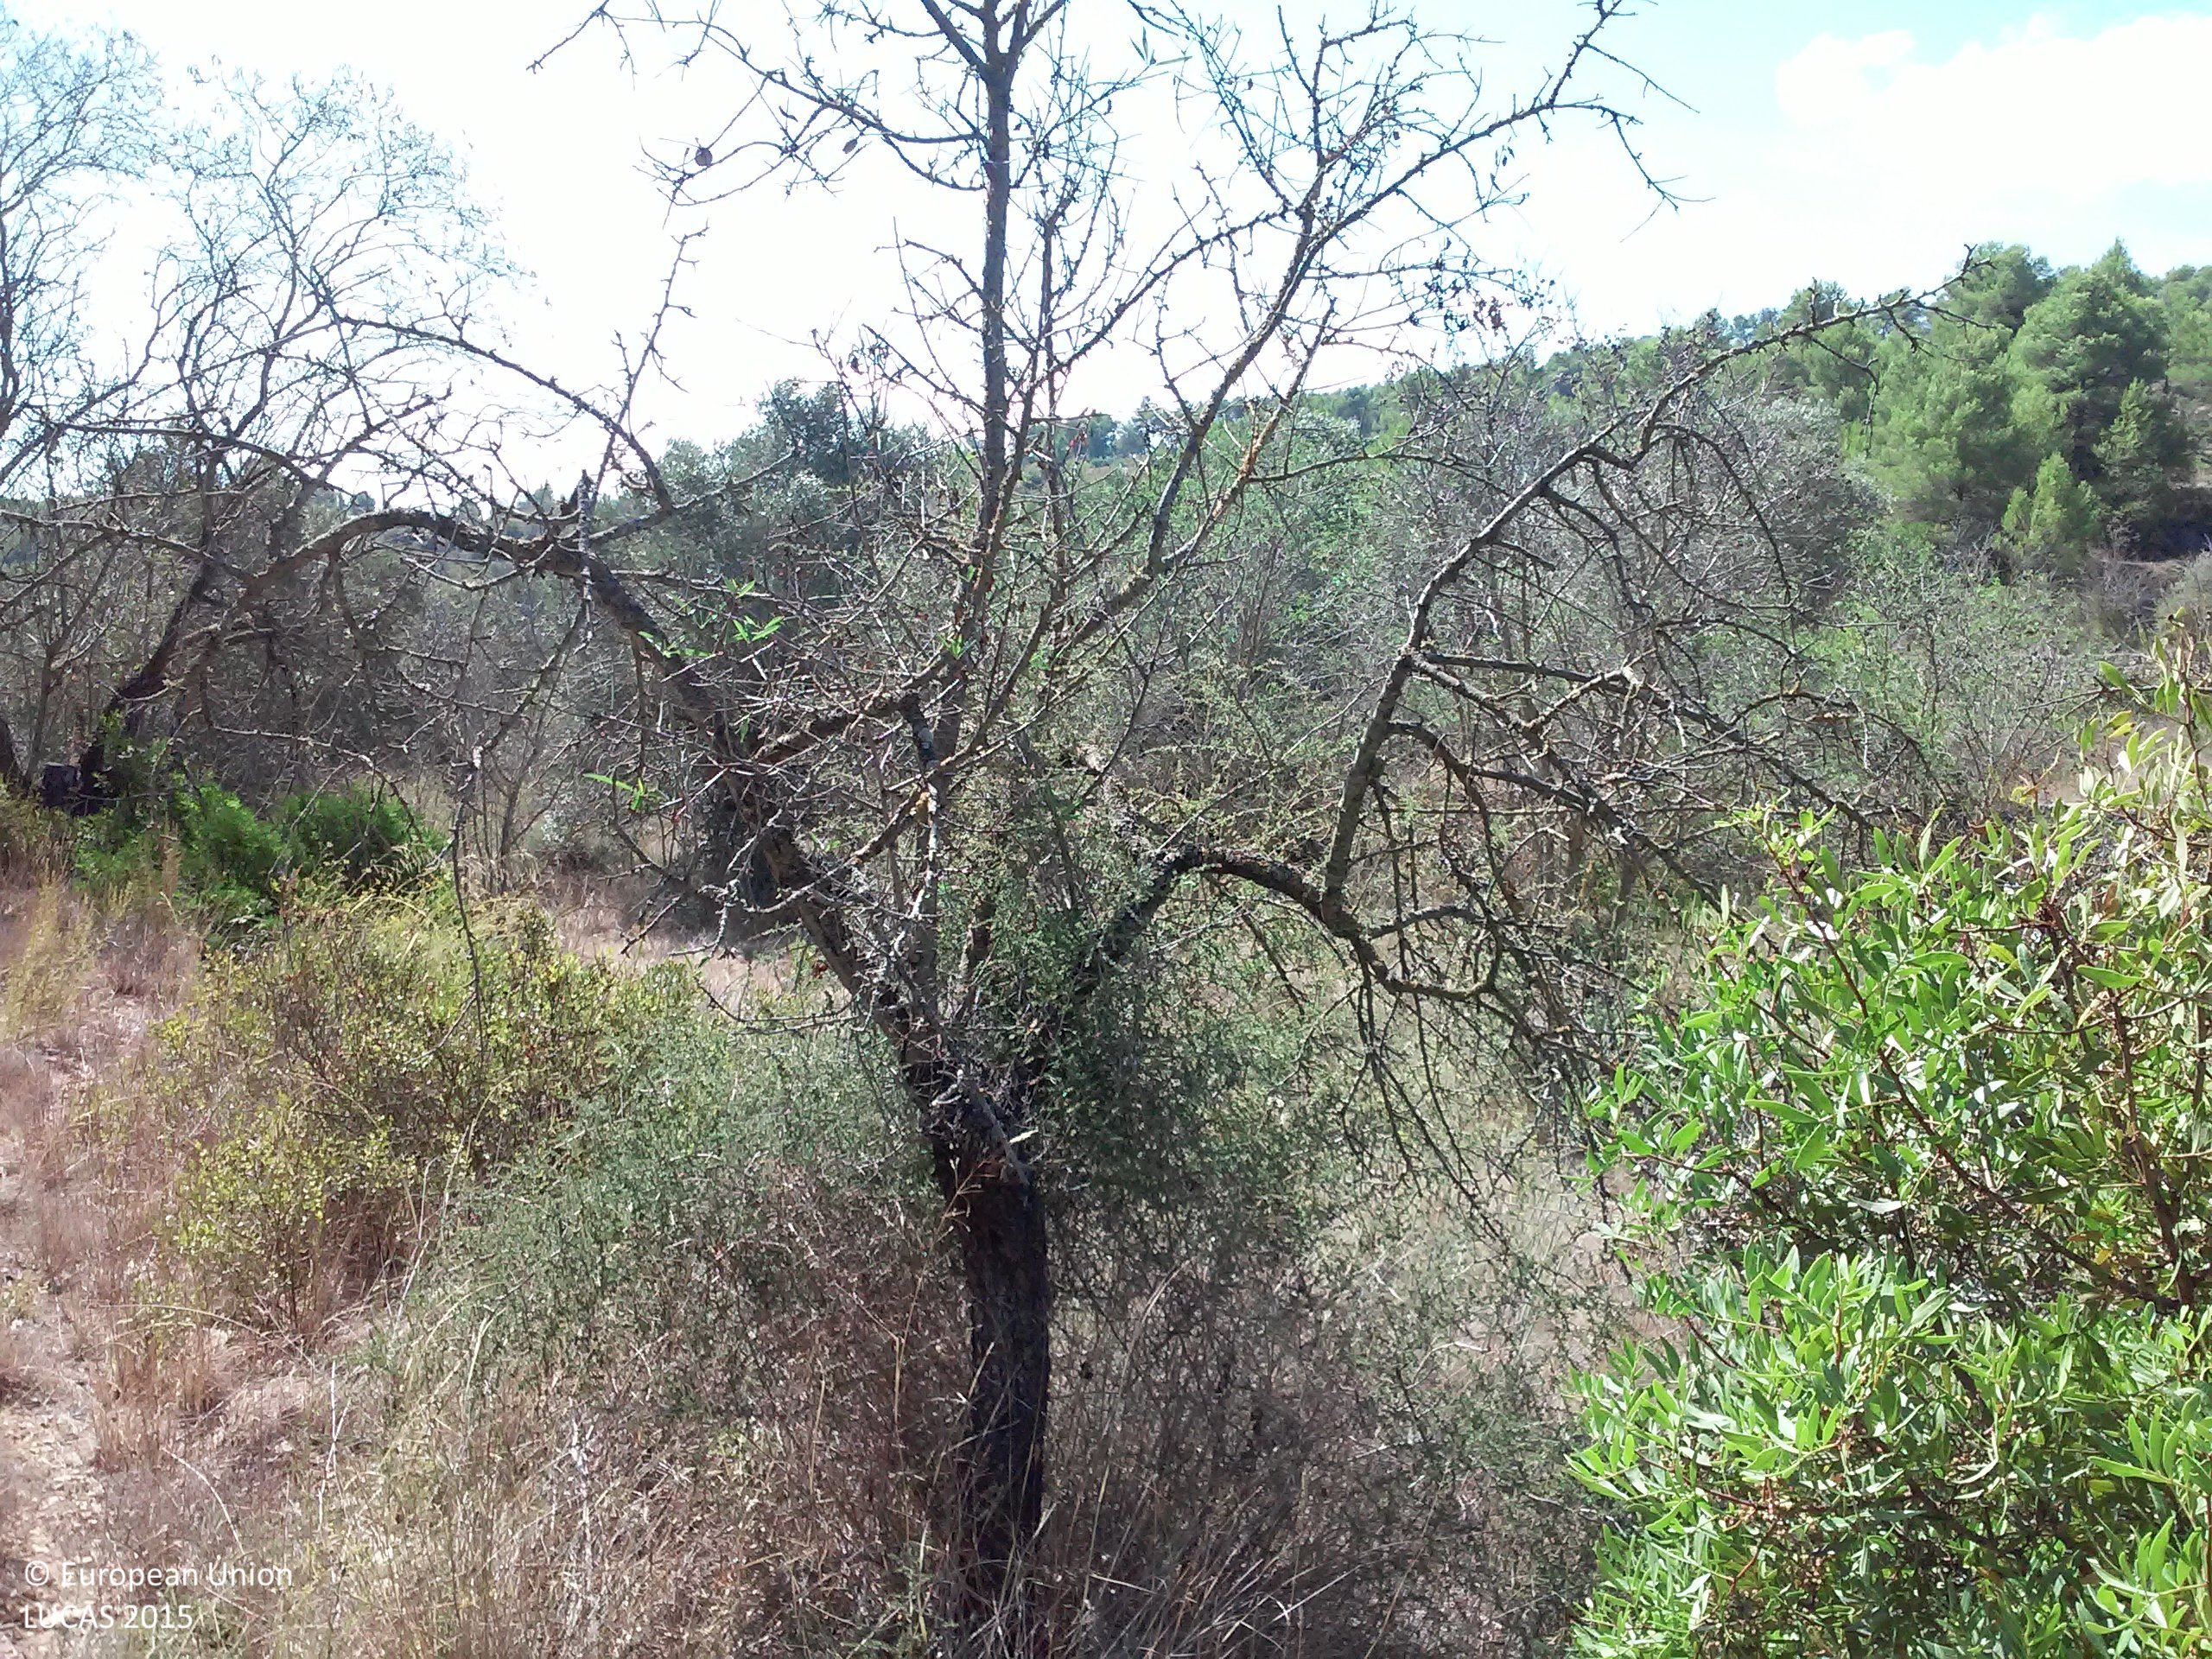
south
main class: Cropland
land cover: Olive groves
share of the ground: < 10 %
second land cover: Shrubland without tree cover
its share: > 75 %
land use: Abandoned areas
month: August
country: ES
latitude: 41.1157
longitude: 0.4994
